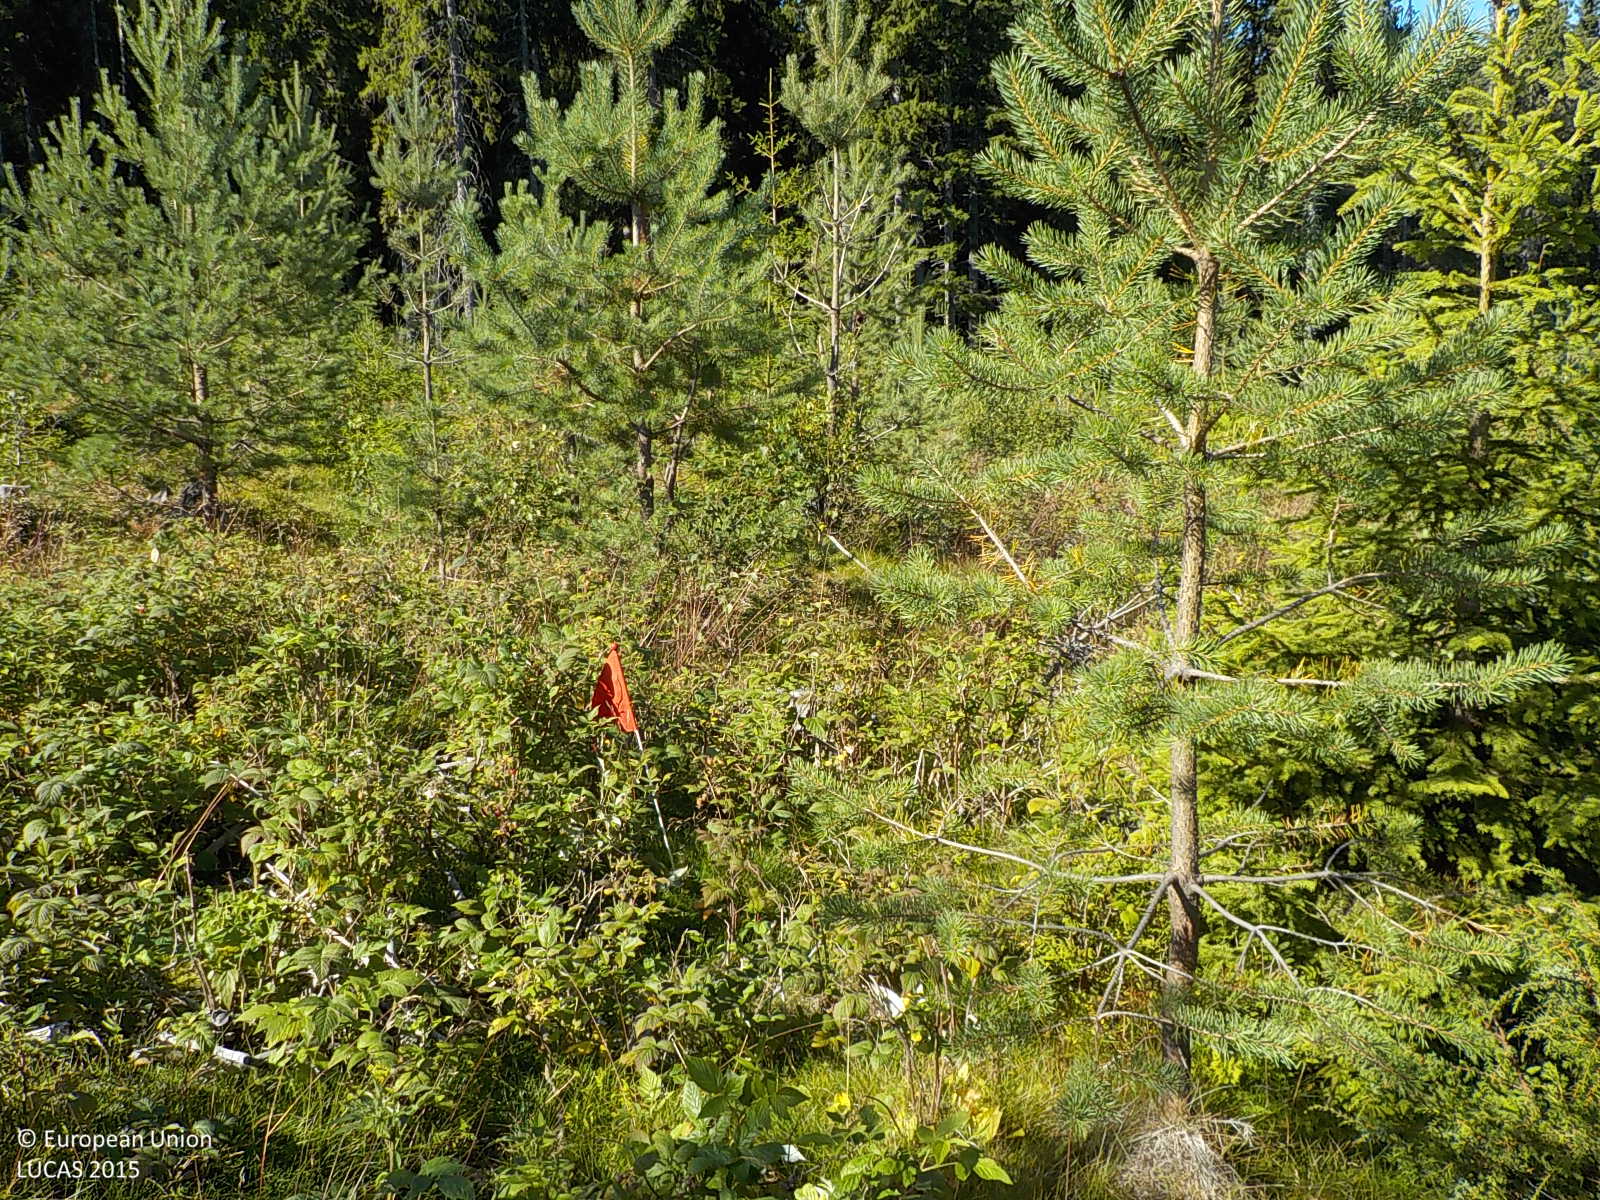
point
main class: Woodland
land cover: Pine dominated coniferous woodland
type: boreal forest
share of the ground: 50 - 75 %
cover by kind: coniferous forest trees 60 %, shrubs 40 %
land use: Forestry
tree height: < 5 m
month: August
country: SE
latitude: 63.4904
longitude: 18.6314
